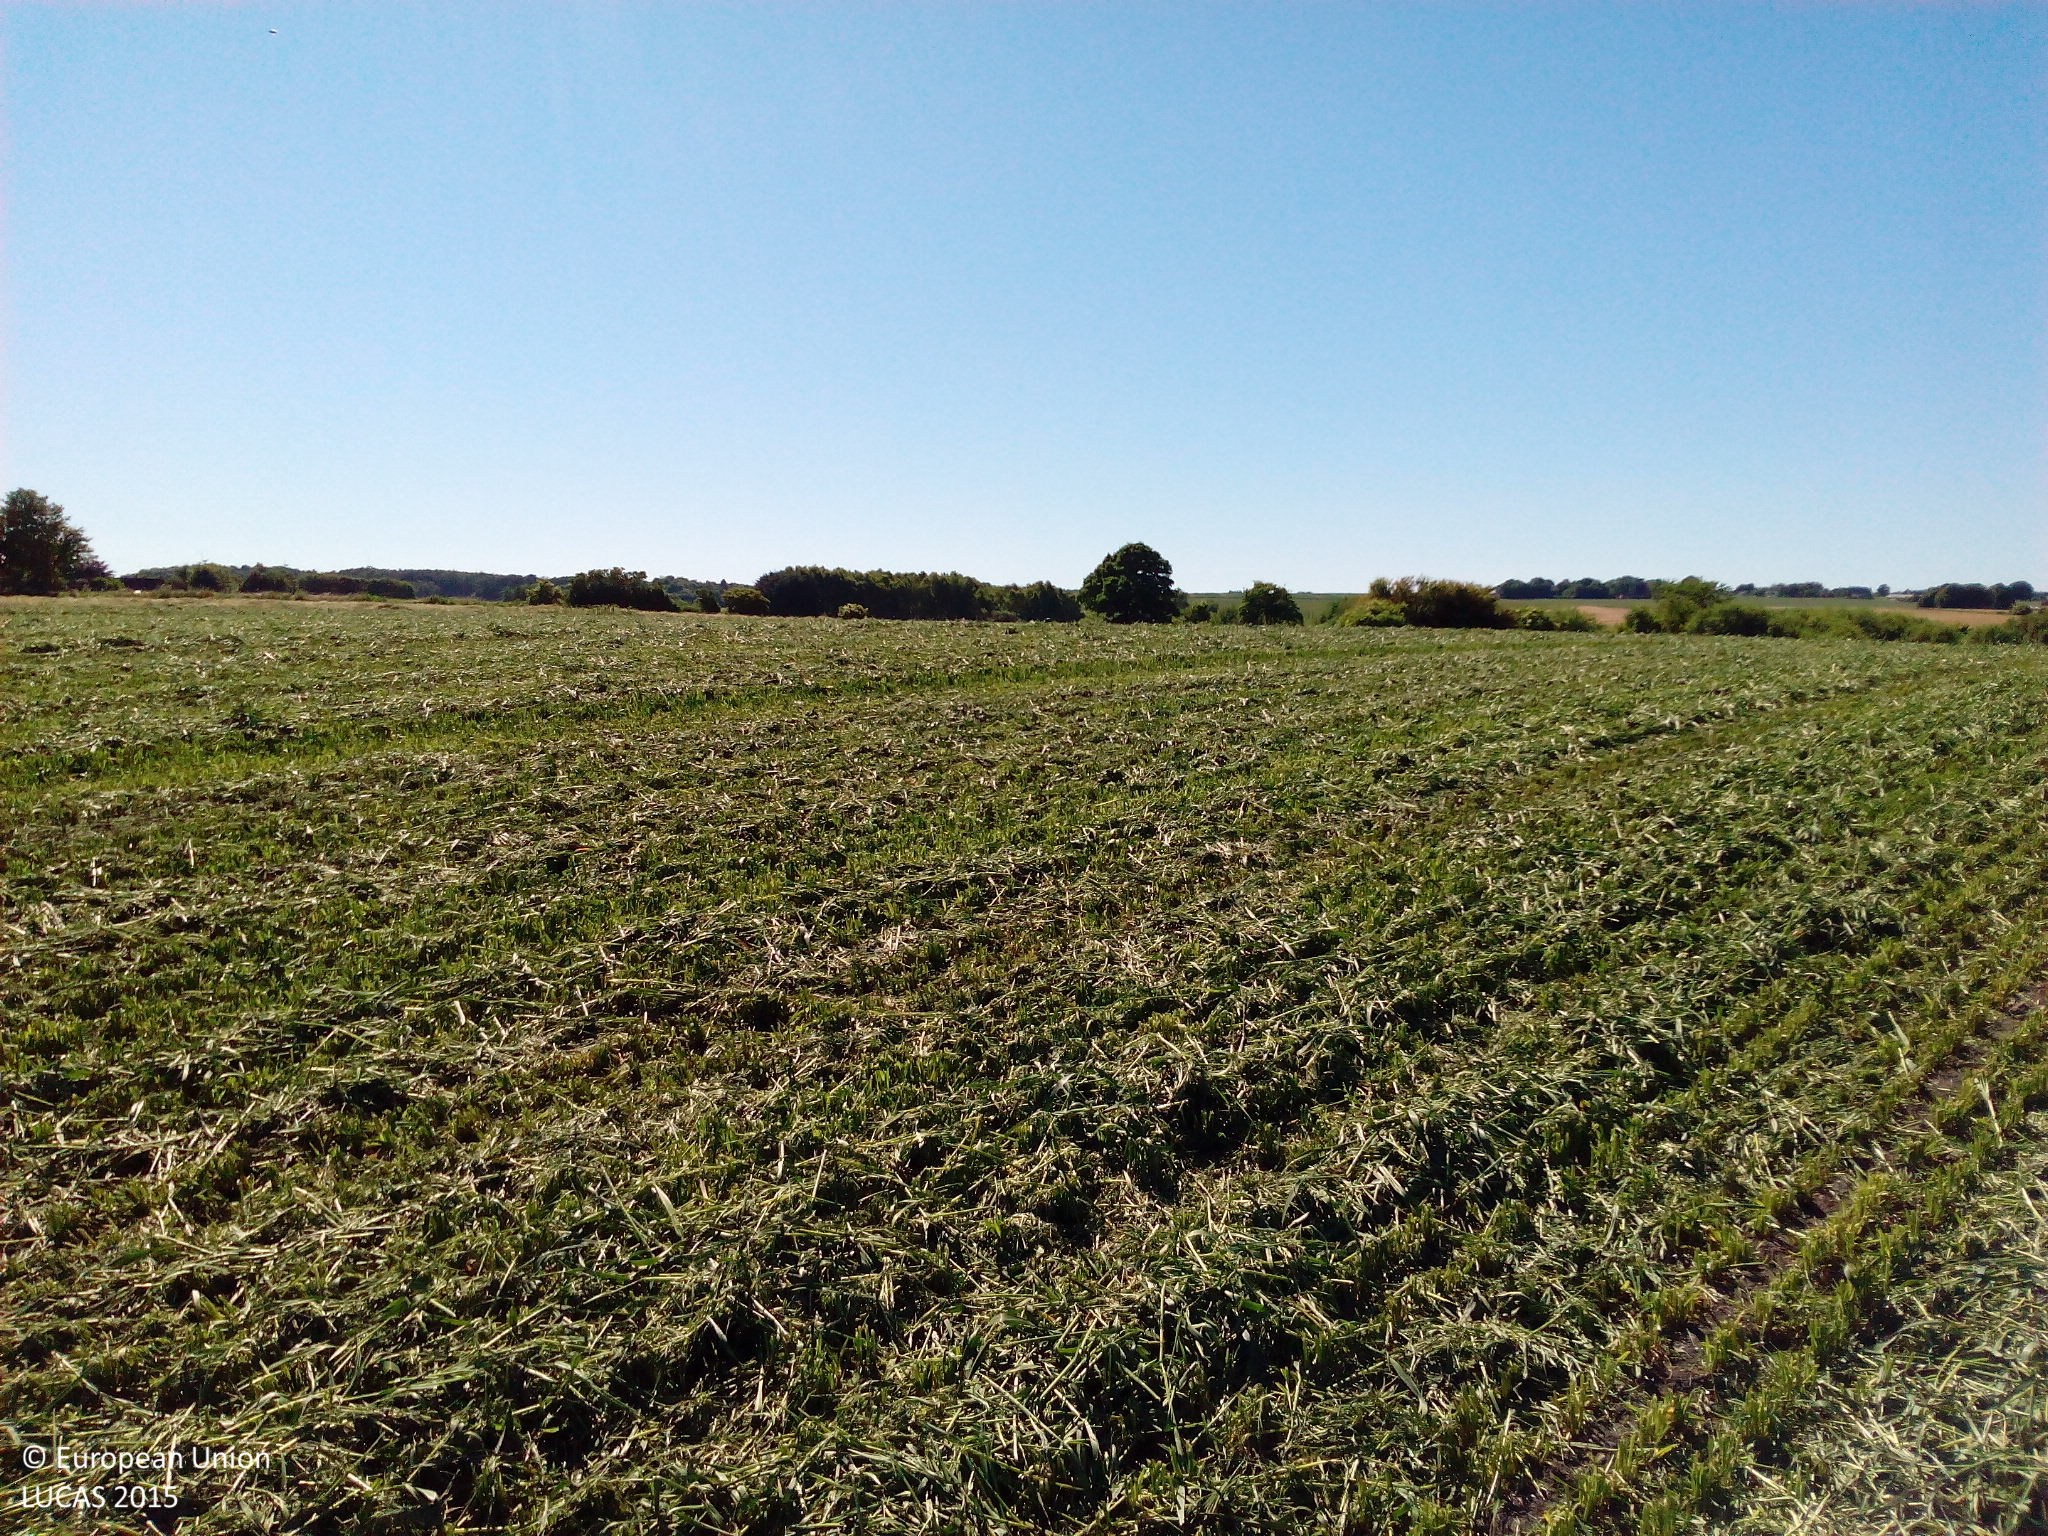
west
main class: Cropland
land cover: Mixed cereals for fodder
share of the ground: 50 - 75 %
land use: Agriculture (excluding fallow land and kitchen gardens)
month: July
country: DK
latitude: 56.4727
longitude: 10.8269
